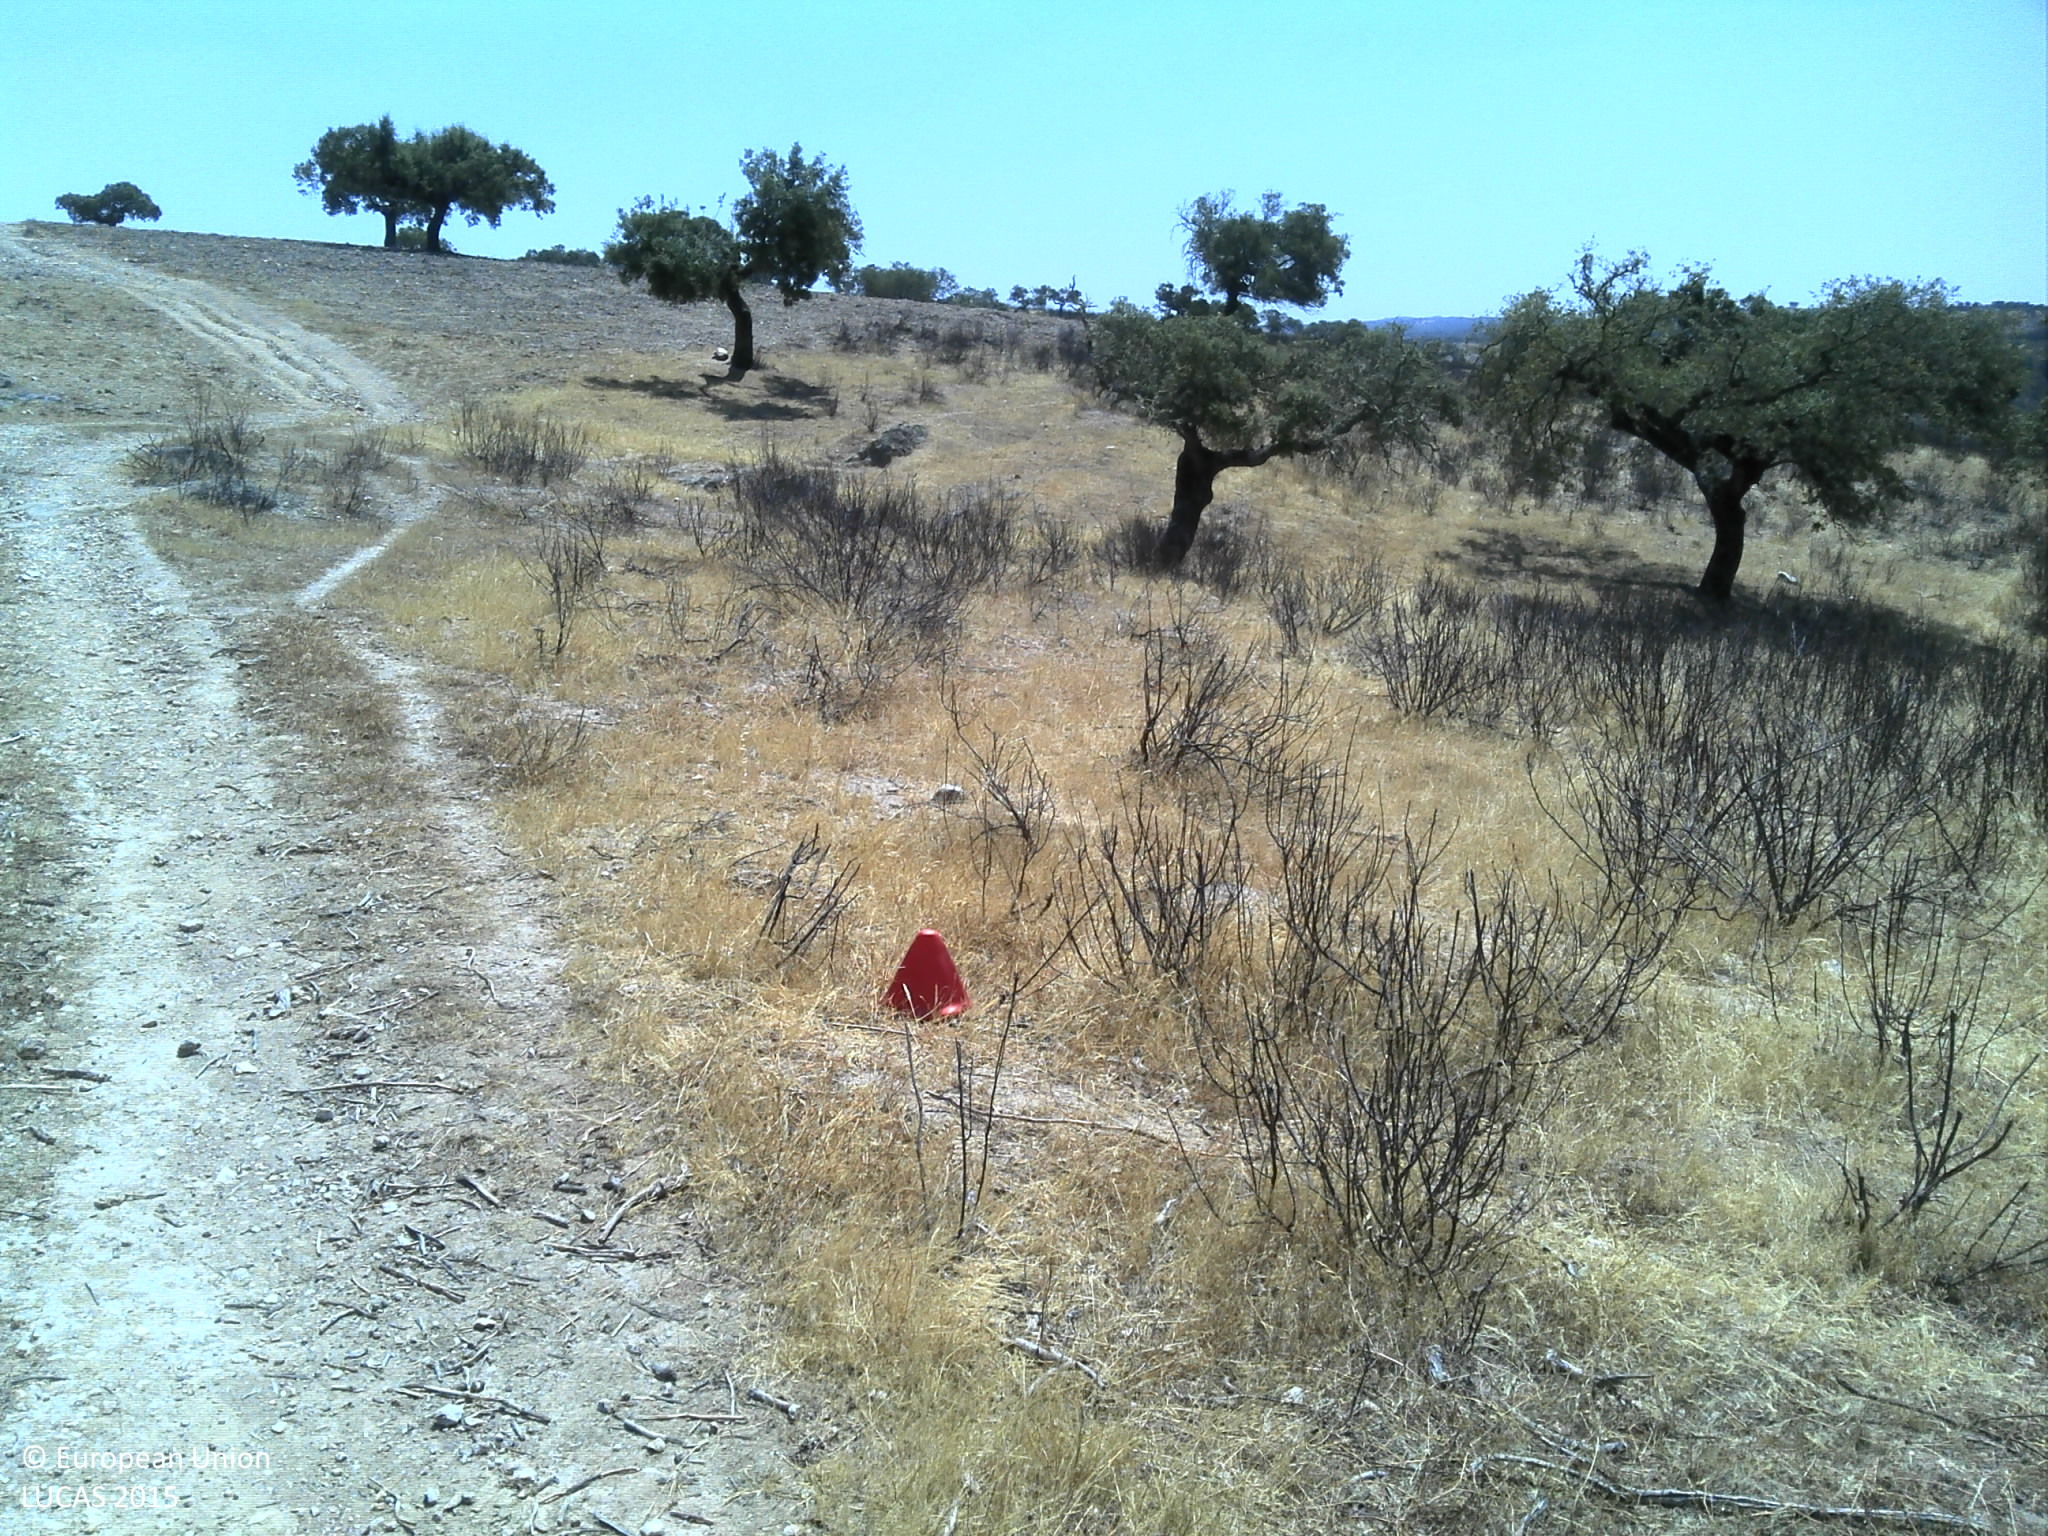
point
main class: Woodland
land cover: Broadleaved woodland
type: broadleaved evergreen forest
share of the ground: 10 - 25 %
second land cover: Grassland without tree/shrub cover
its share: 10 - 25 %
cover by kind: herbaceous plants 65 %, unconsolidated bare surface 25 %, broadleaved forest trees 10 %
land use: Forestry
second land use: Agriculture (excluding fallow land and kitchen gardens)
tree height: < 5 m
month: June
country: PT
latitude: 38.0804
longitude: -7.1479
